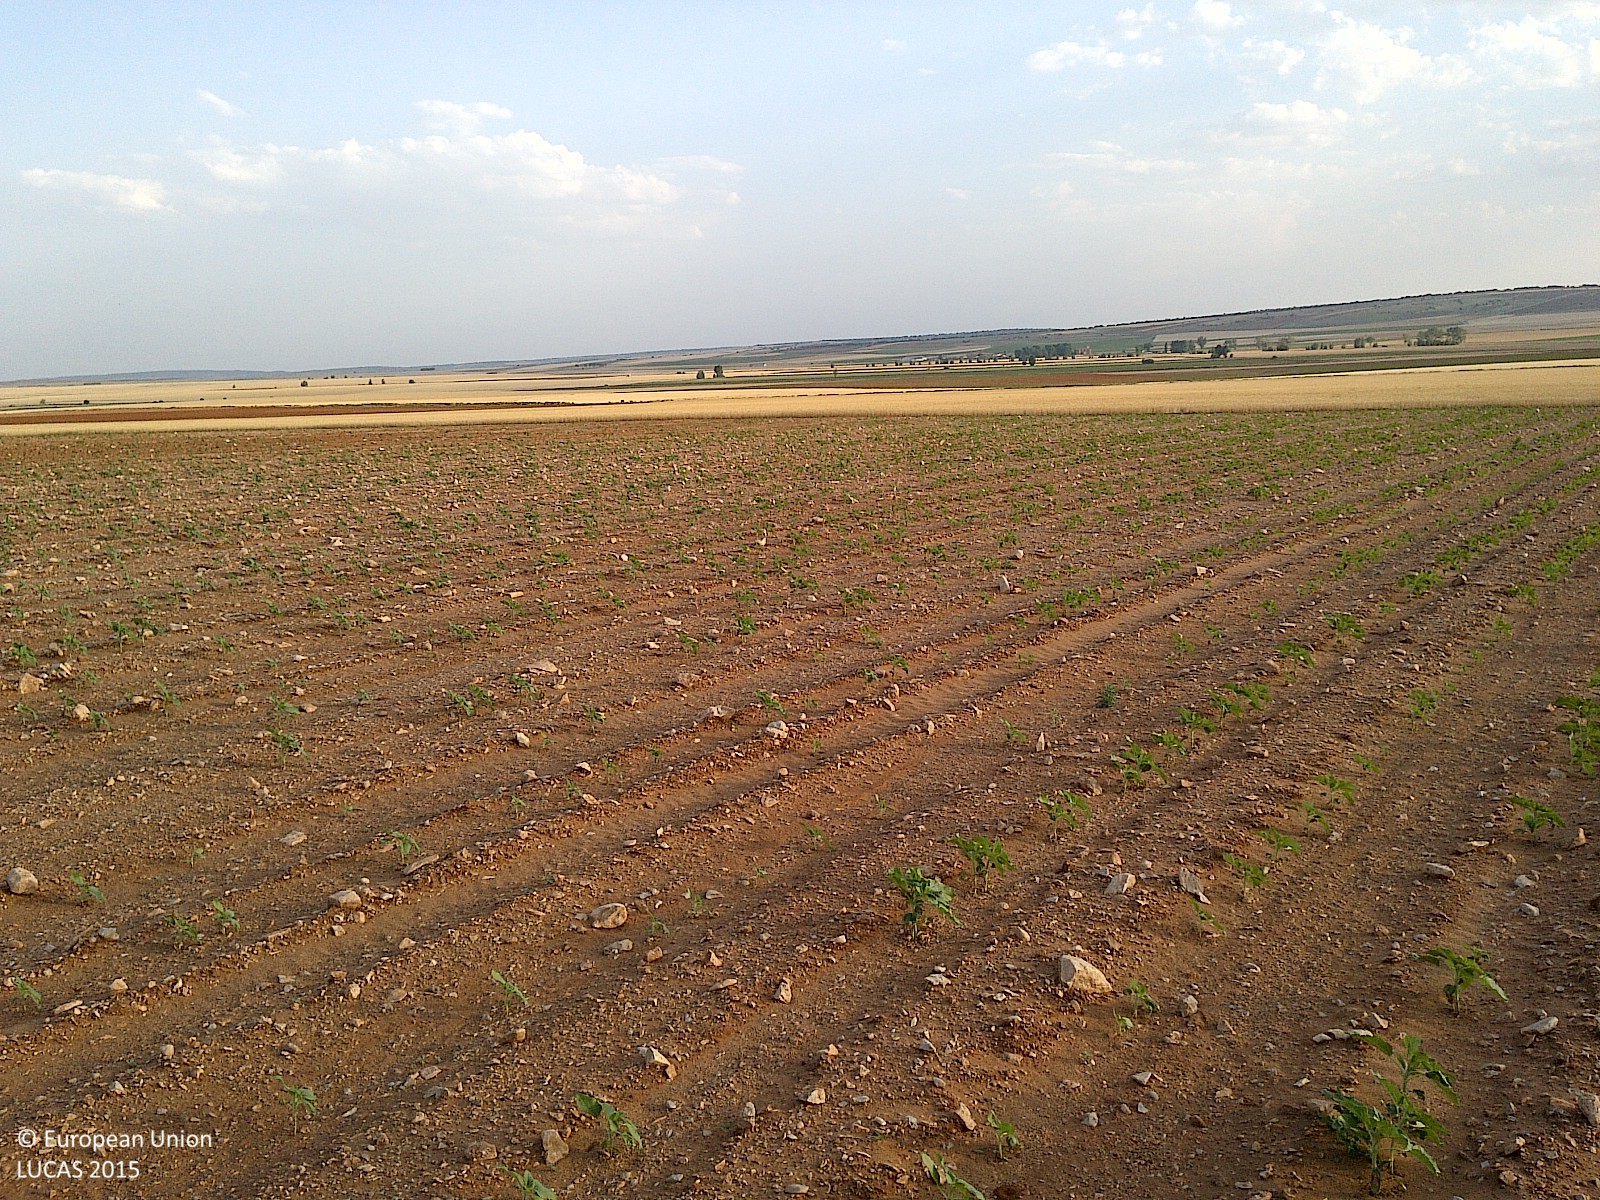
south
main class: Cropland
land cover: Sunflower
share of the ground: < 10 %
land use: Agriculture (excluding fallow land and kitchen gardens)
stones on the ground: < 10 %
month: June
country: ES
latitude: 41.6463
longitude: -2.1478
